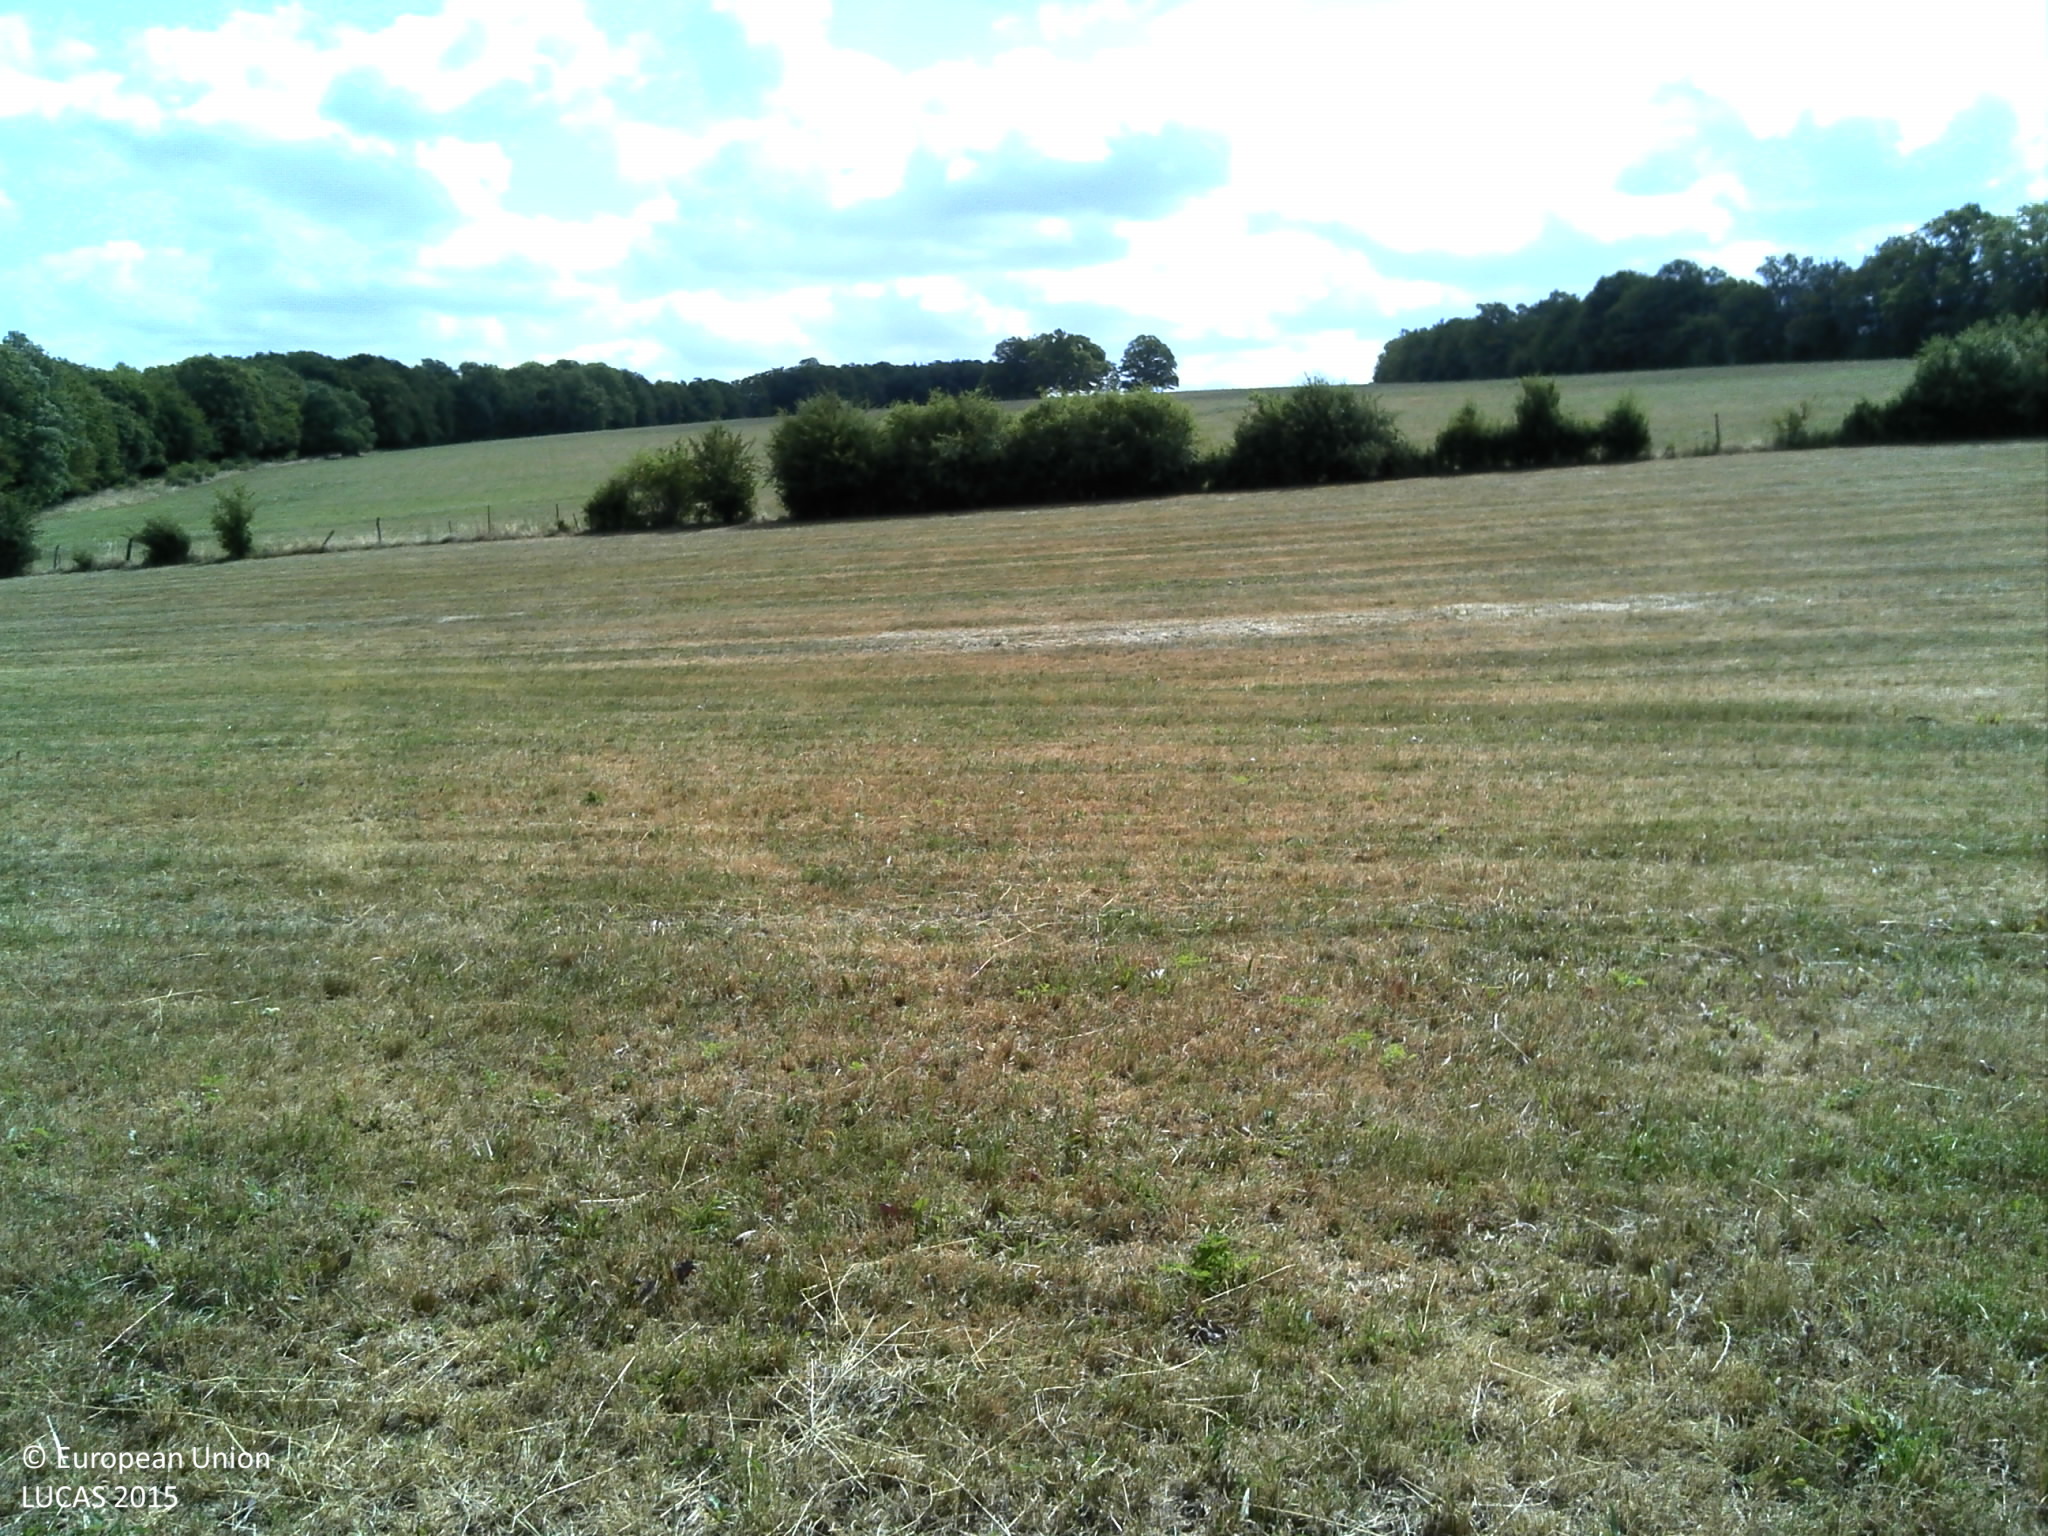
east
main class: Grassland
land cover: Grassland without tree/shrub cover
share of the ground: > 75 %
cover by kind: herbaceous plants 100 %
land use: Agriculture (excluding fallow land and kitchen gardens)
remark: Harvested field
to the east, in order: Grassland without tree/shrub cover; Abandoned hedges; Fences; Grassland without tree/shrub cover
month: July
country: FR
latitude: 48.1778
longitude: 6.2484
